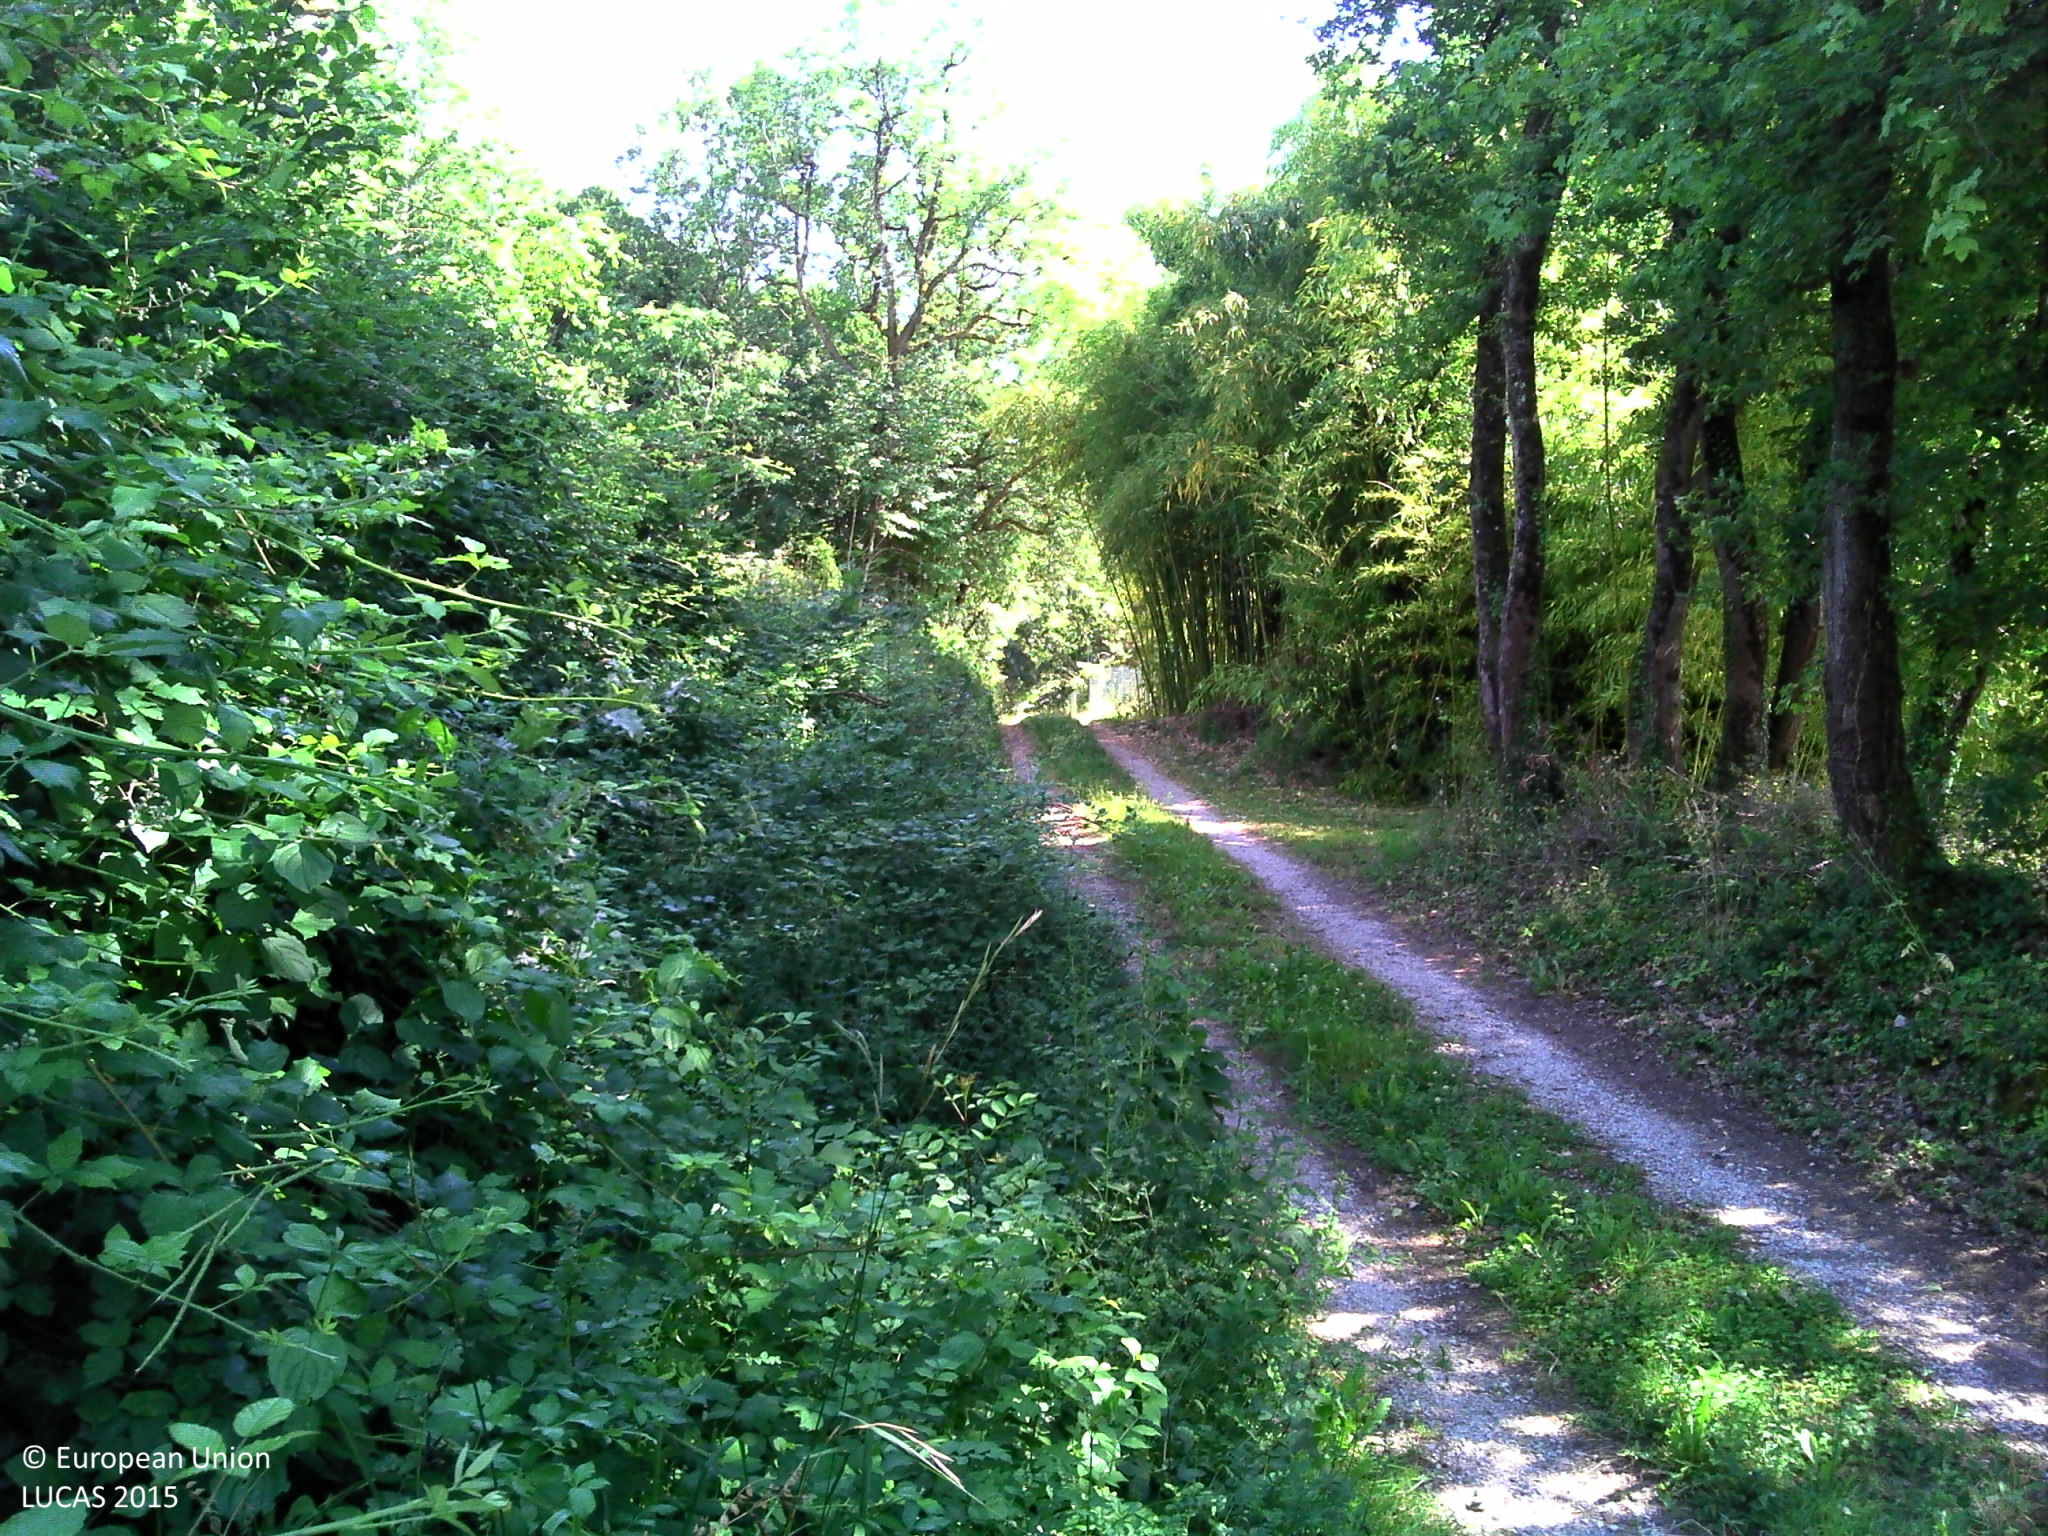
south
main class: Woodland
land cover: Broadleaved woodland
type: thermophilous deciduous forest
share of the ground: > 75 %
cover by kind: broadleaved forest trees 65 %, shrubs 30 %, herbaceous plants 5 %
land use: Forestry
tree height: > 5 m
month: June
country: FR
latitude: 45.6846
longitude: 0.4200
